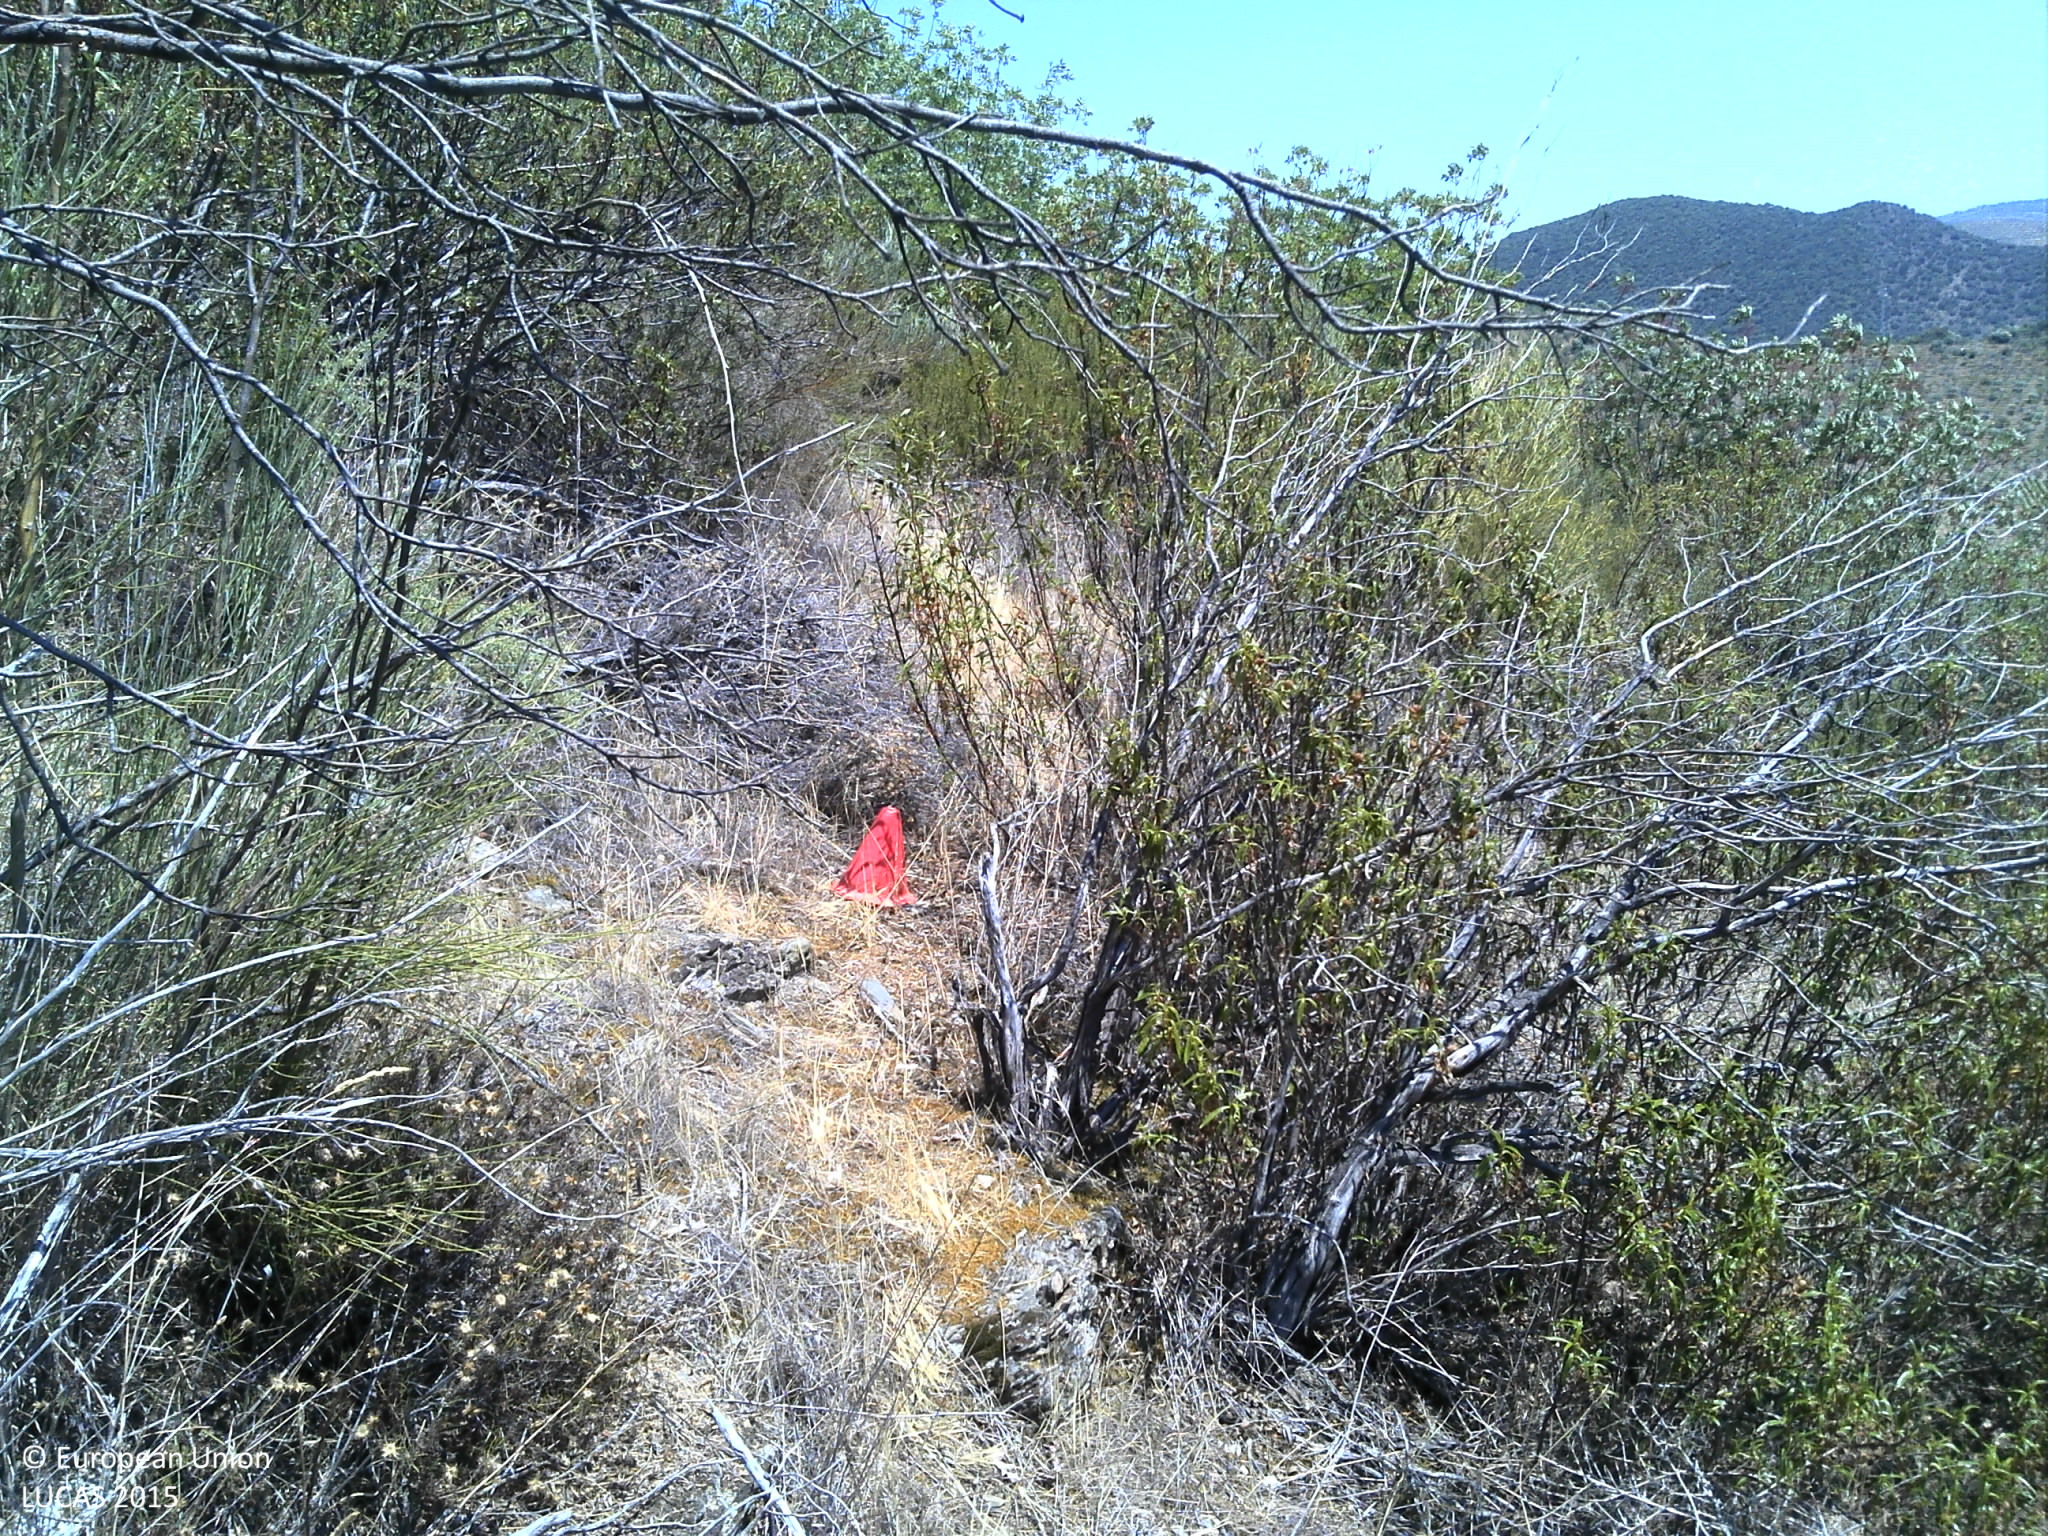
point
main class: Shrubland
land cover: Shrubland without tree cover
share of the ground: > 75 %
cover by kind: shrubs 95 %, unconsolidated bare surface 5 %
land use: Semi-natural and natural areas not in use
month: June
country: PT
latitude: 41.0409
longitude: -6.9874
